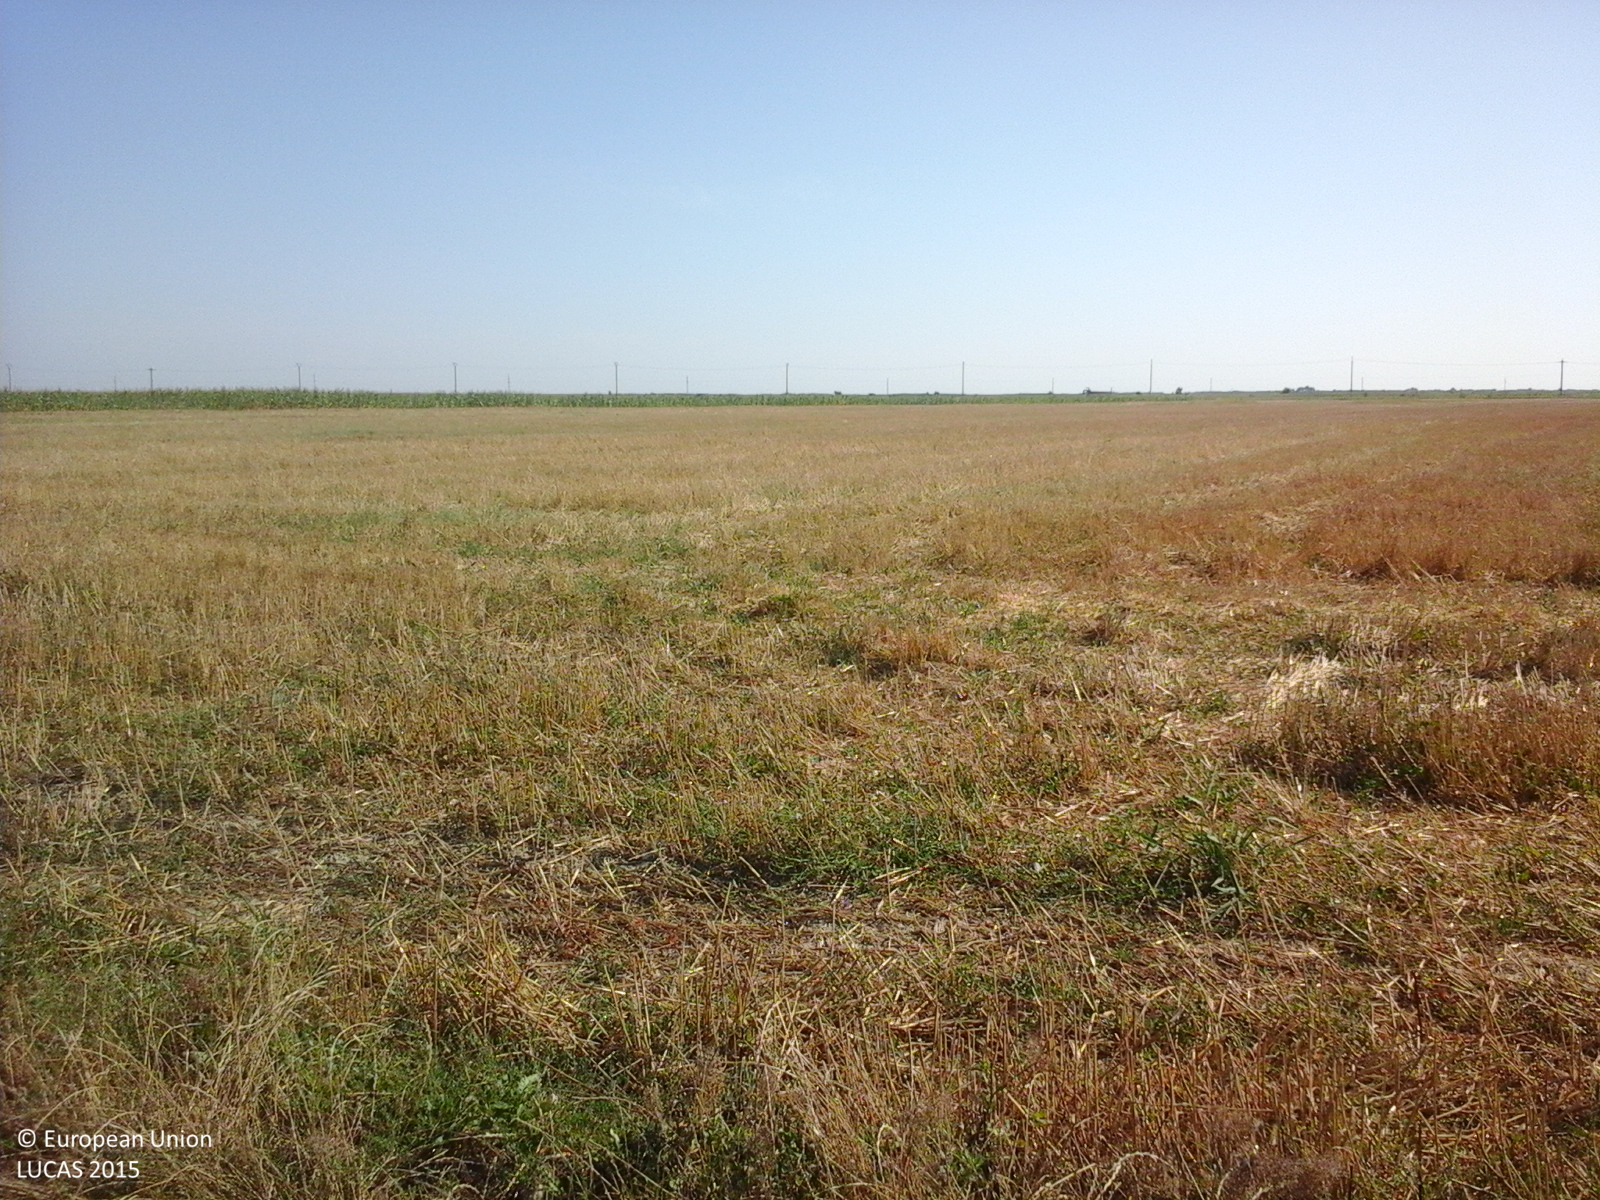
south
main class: Cropland
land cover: Sunflower
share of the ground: > 75 %
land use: Agriculture (excluding fallow land and kitchen gardens)
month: August
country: RO
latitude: 45.5981
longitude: 27.4734
